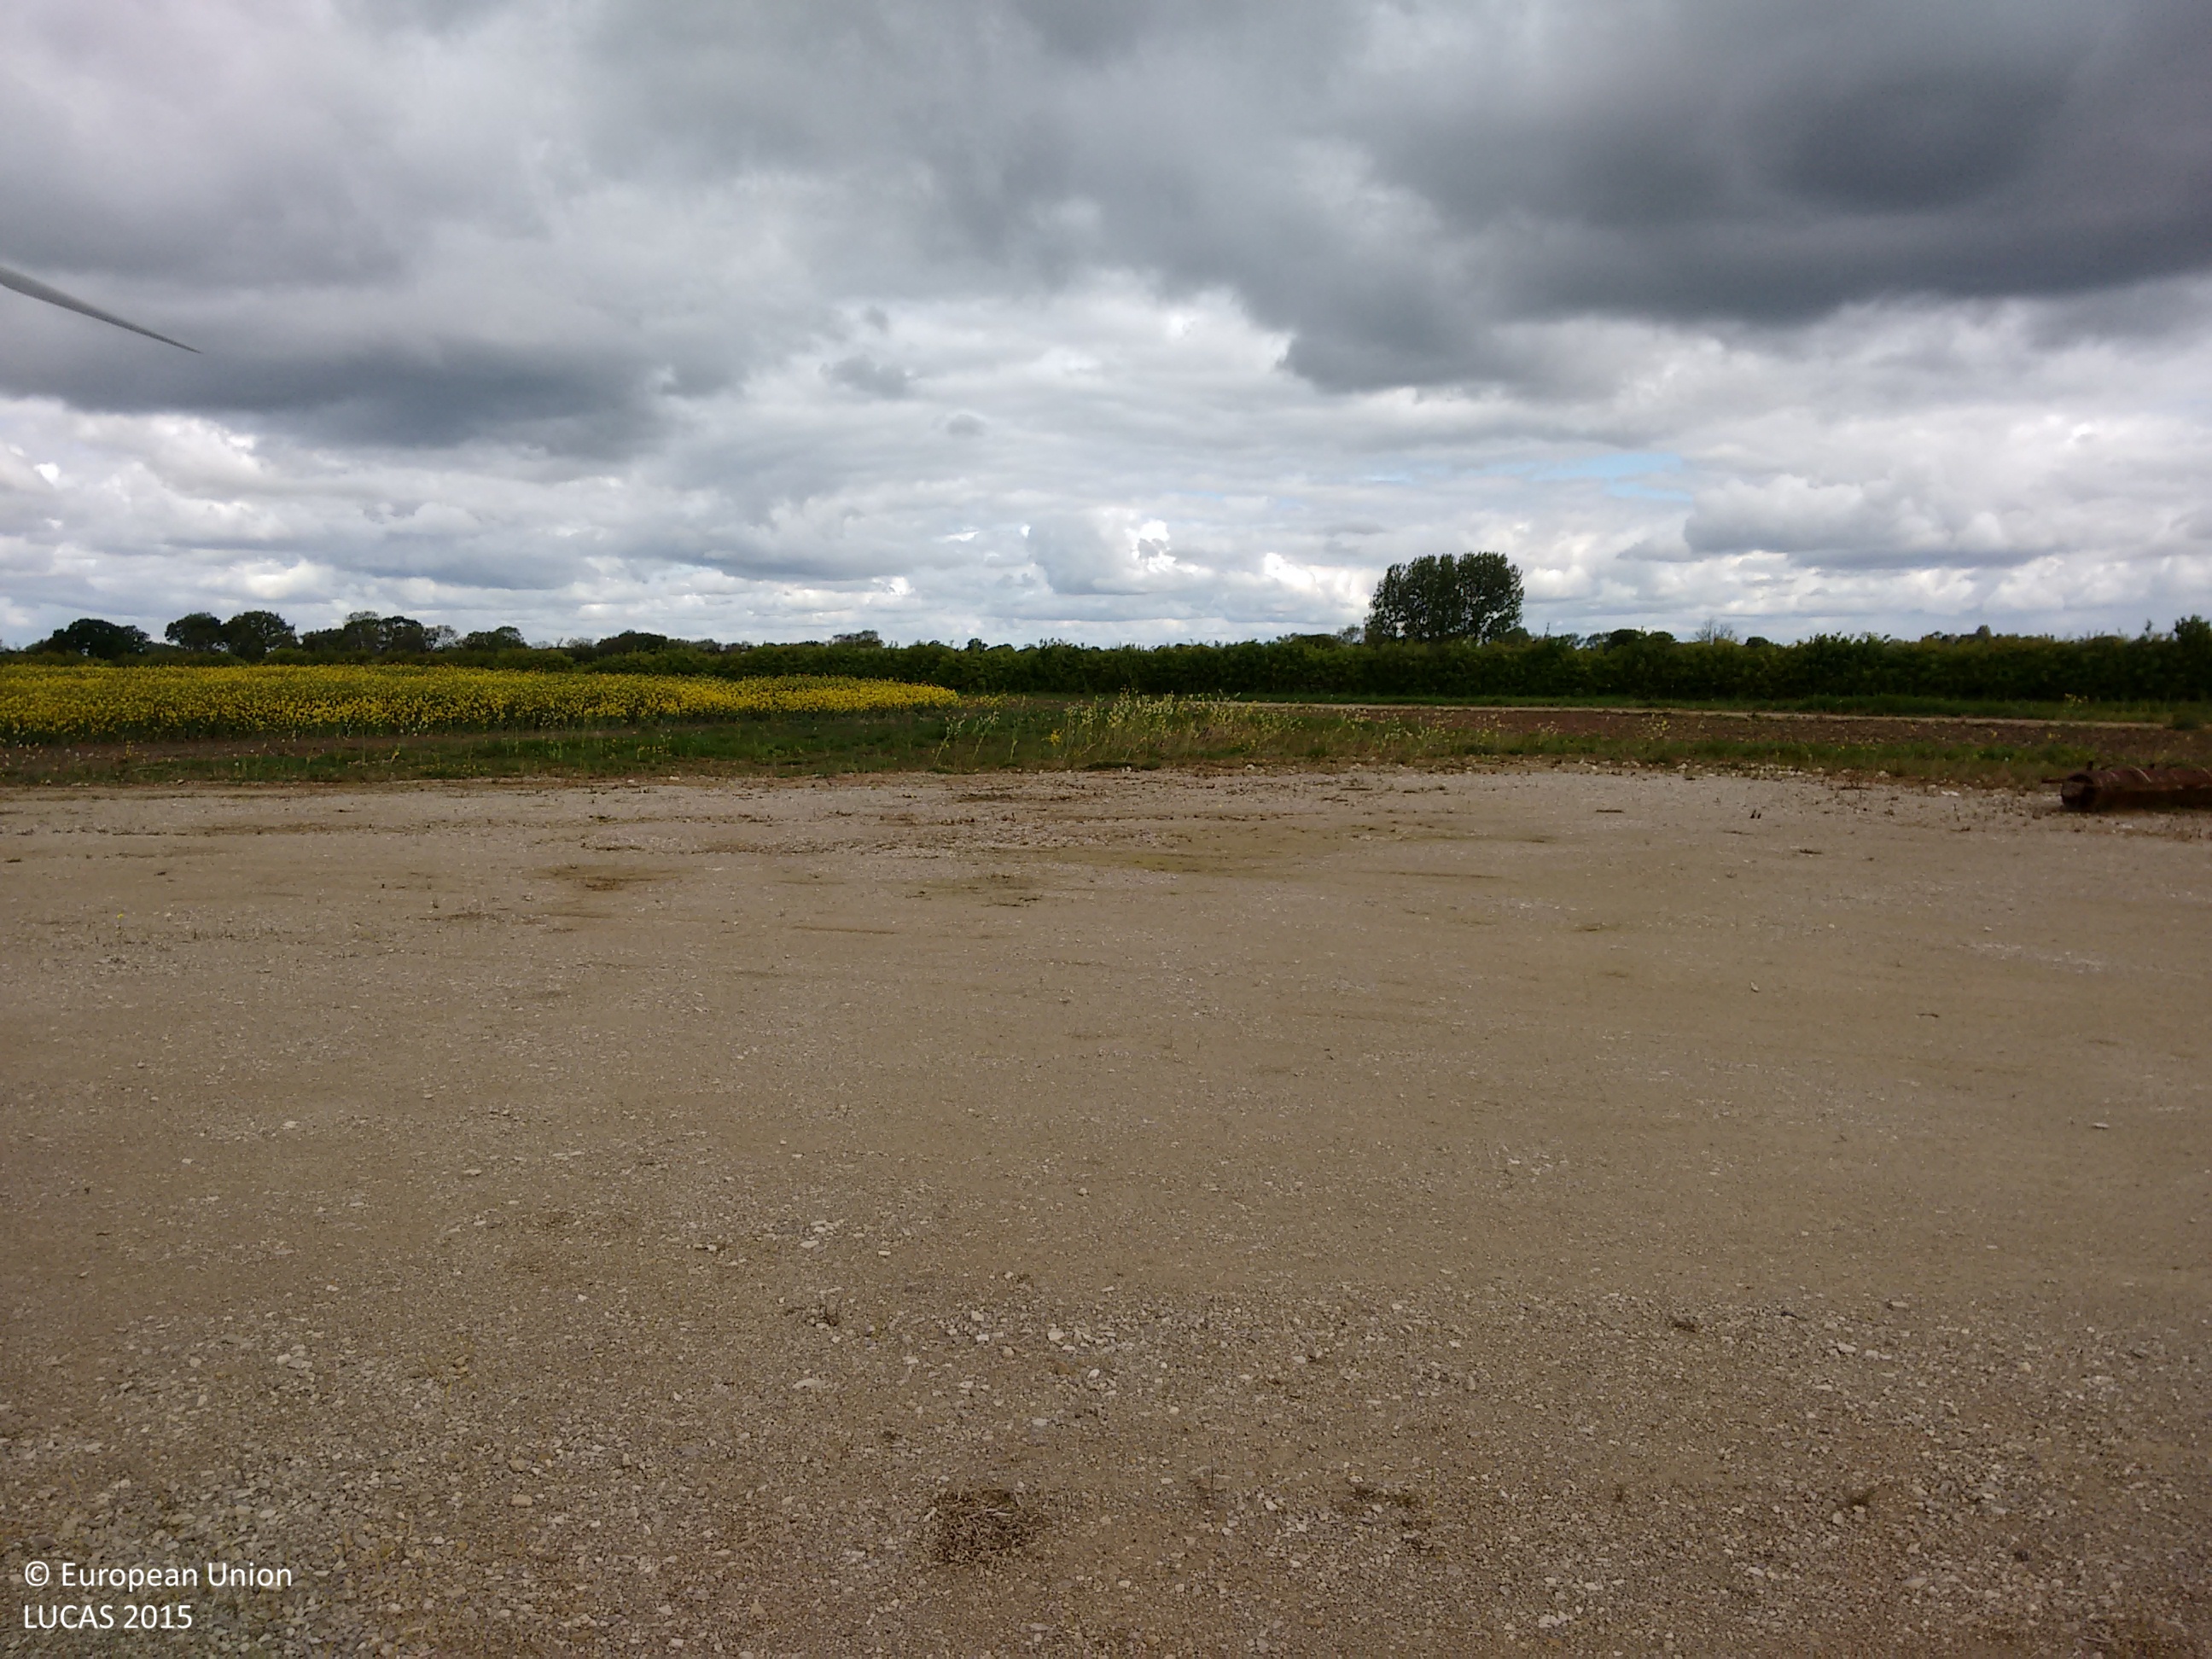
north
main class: Cropland
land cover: Rape and turnip rape
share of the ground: > 75 %
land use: Agriculture (excluding fallow land and kitchen gardens)
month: May
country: GB
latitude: 53.7350
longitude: -0.7884
